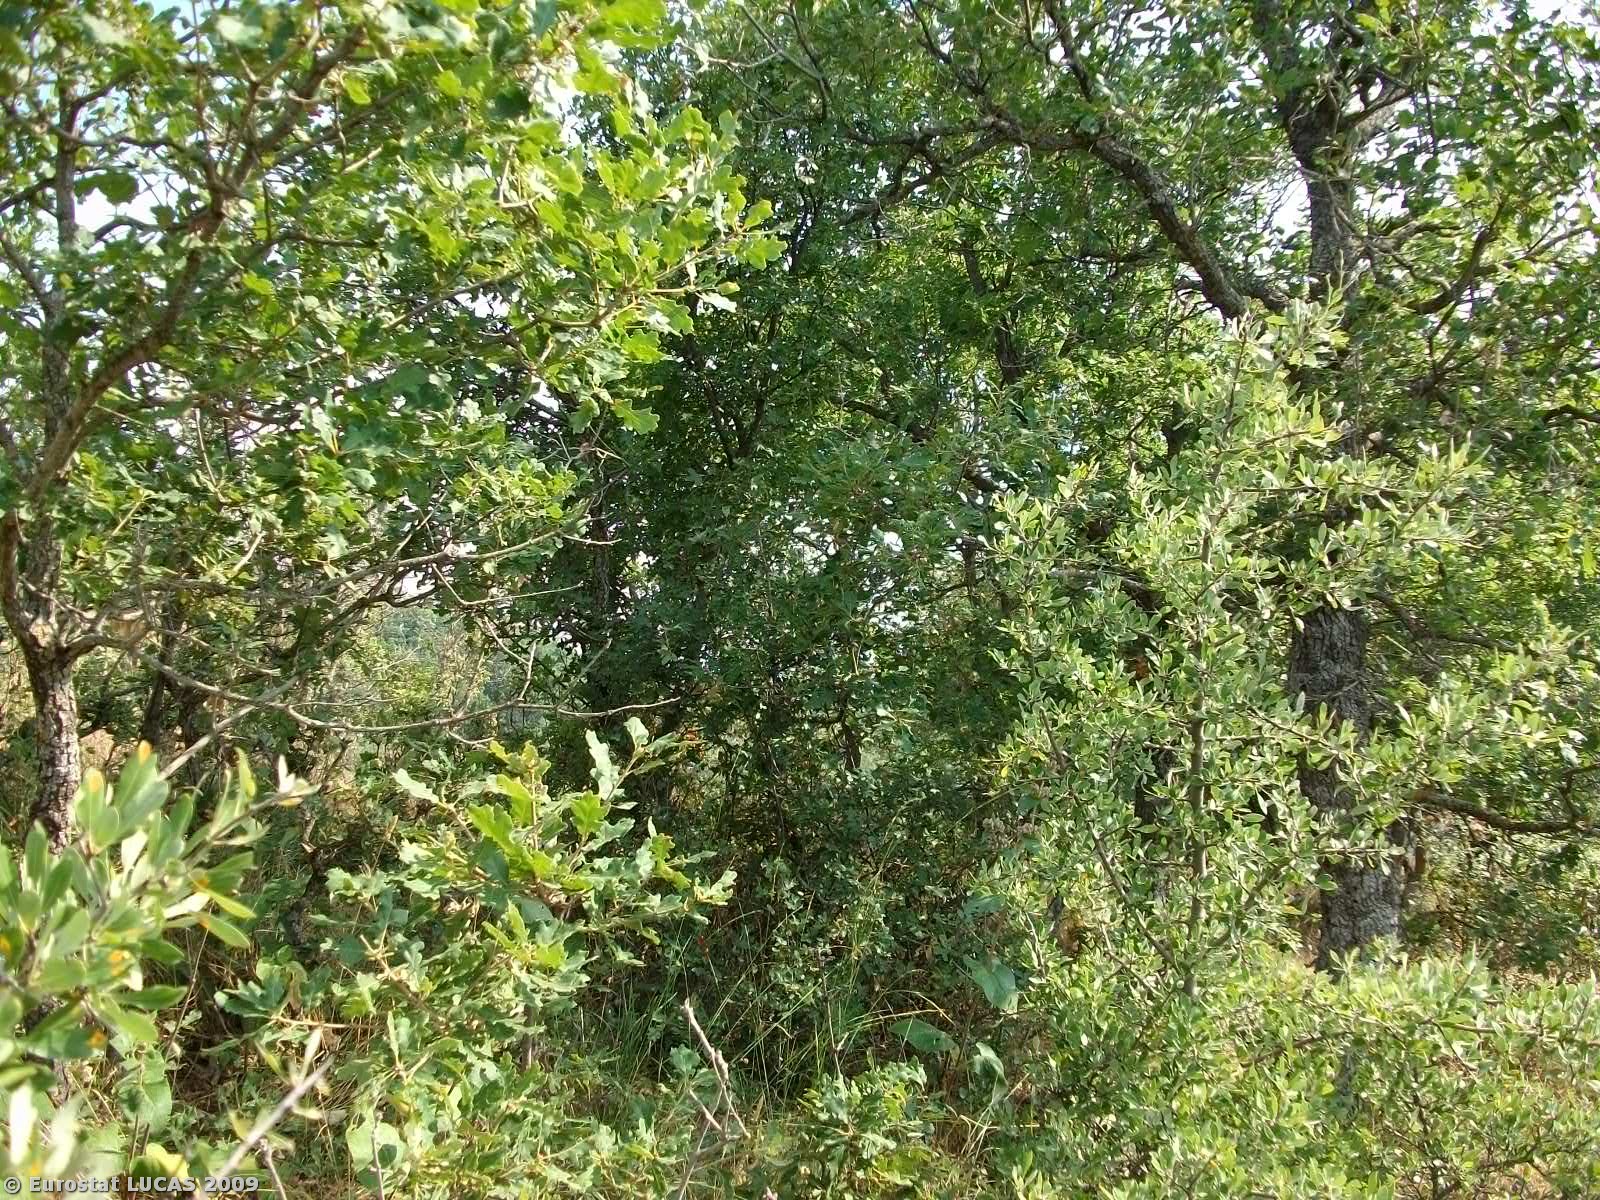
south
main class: Woodland
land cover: Broadleaved woodland
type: thermophilous deciduous forest
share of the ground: 50 - 75 %
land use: Forestry
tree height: > 5 m
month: July
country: GR
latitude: 39.7993
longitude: 21.7233
